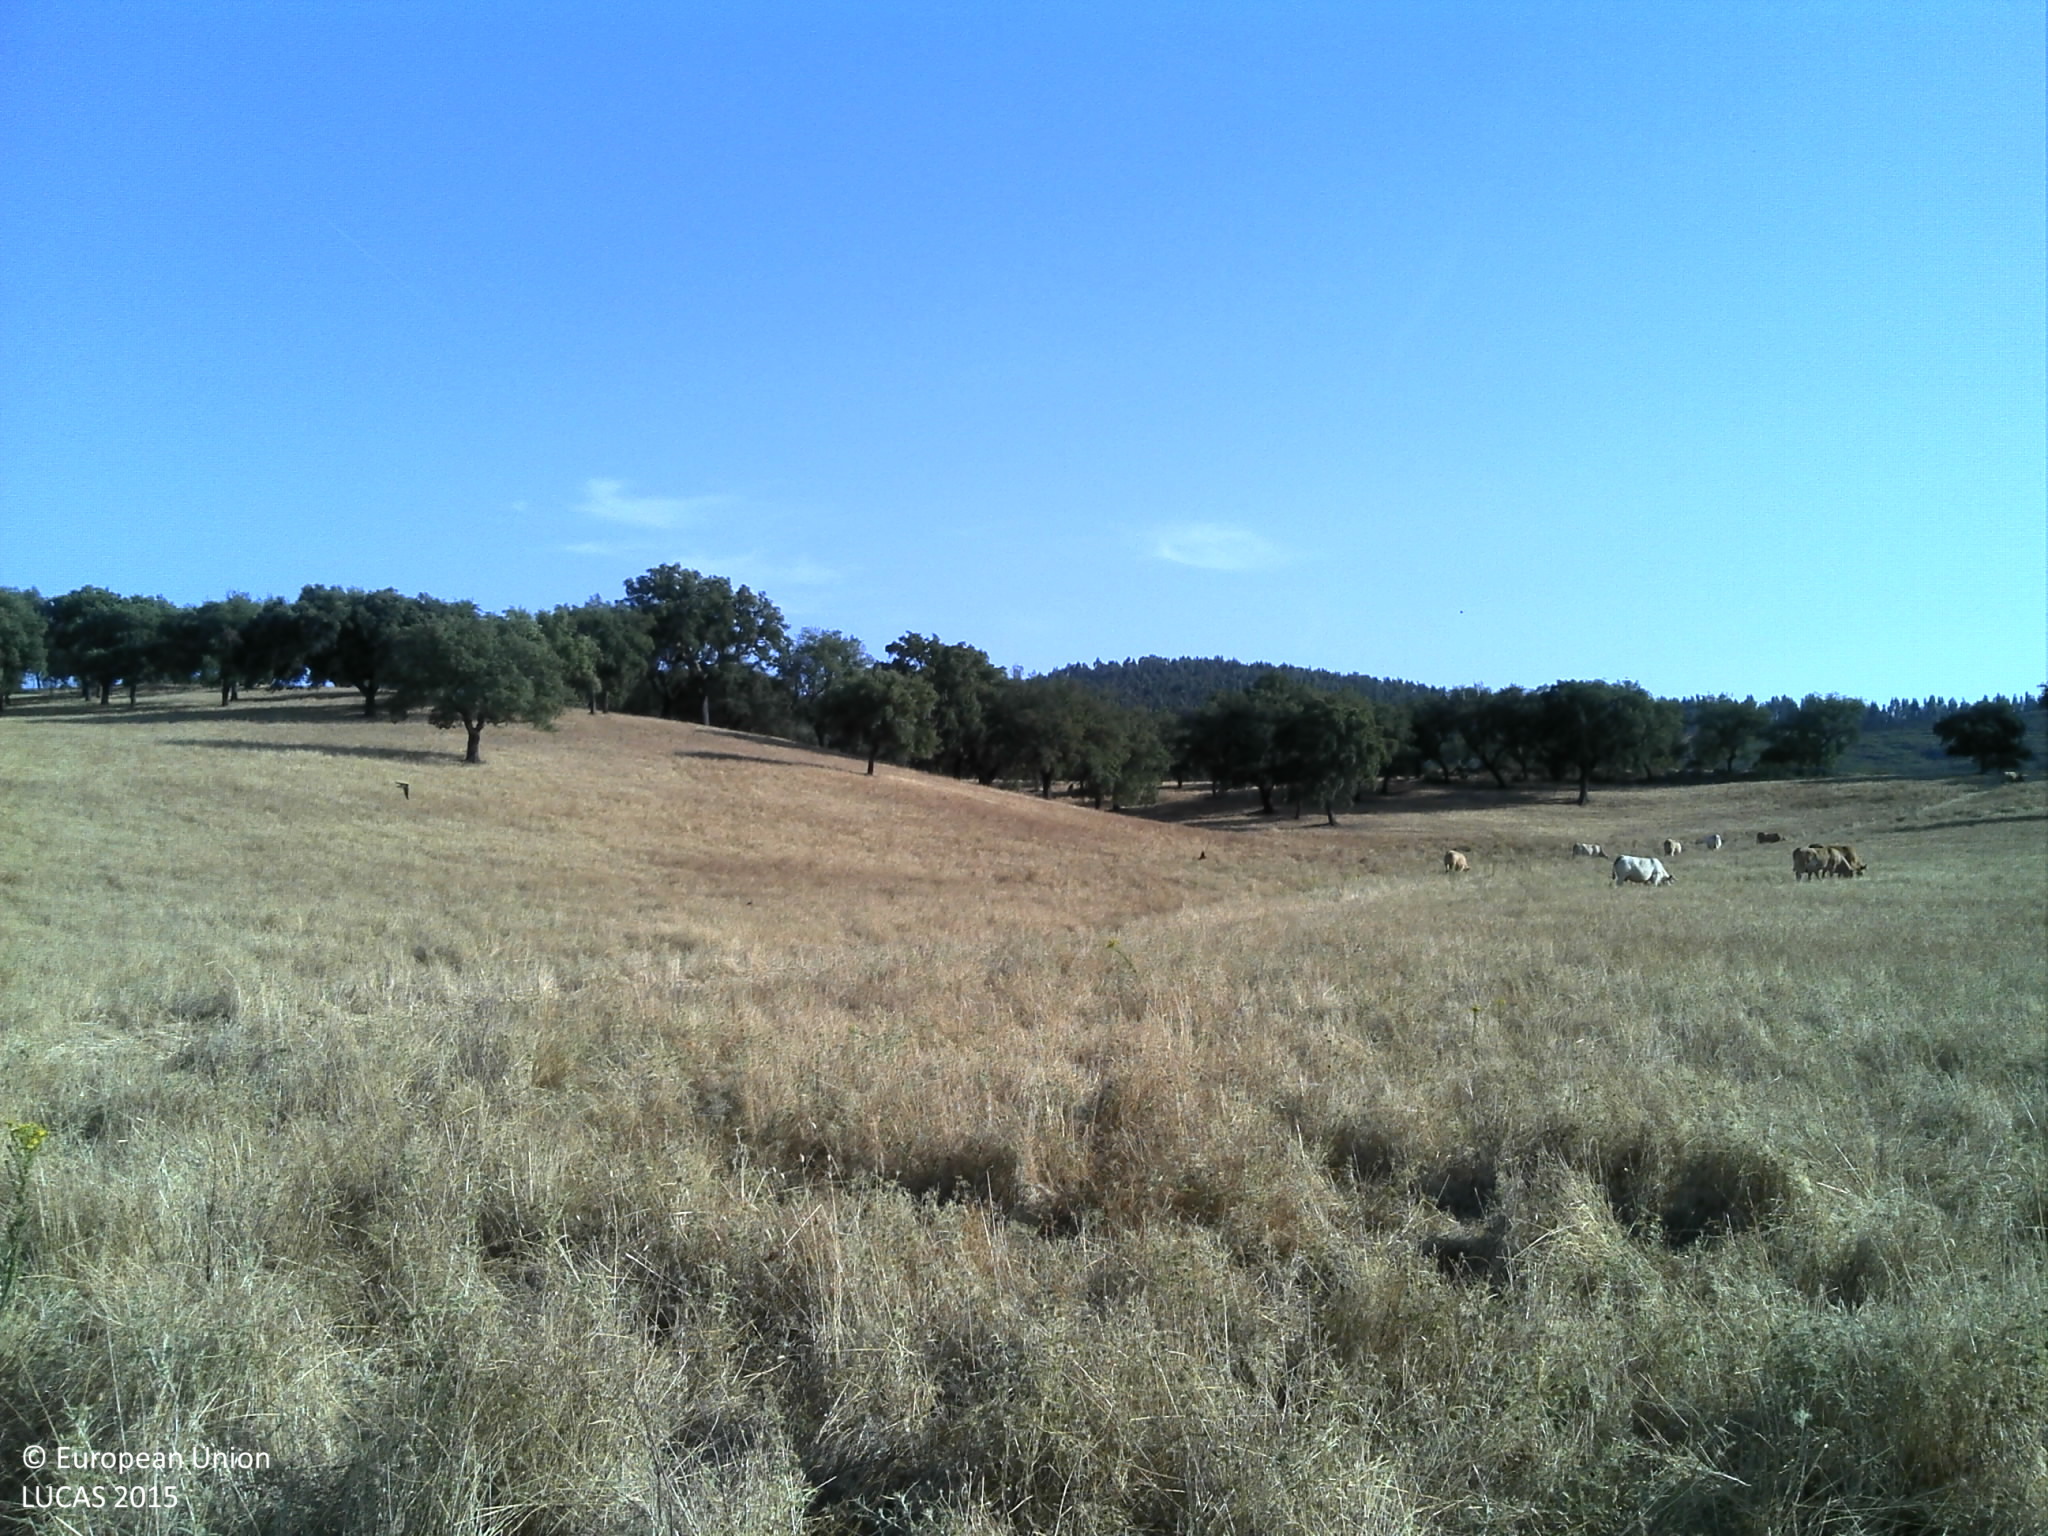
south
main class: Grassland
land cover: Grassland without tree/shrub cover
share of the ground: 50 - 75 %
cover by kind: herbaceous plants 75 %, unconsolidated bare surface 25 %
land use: Agriculture (excluding fallow land and kitchen gardens)
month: July
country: PT
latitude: 38.7657
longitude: -7.5393
